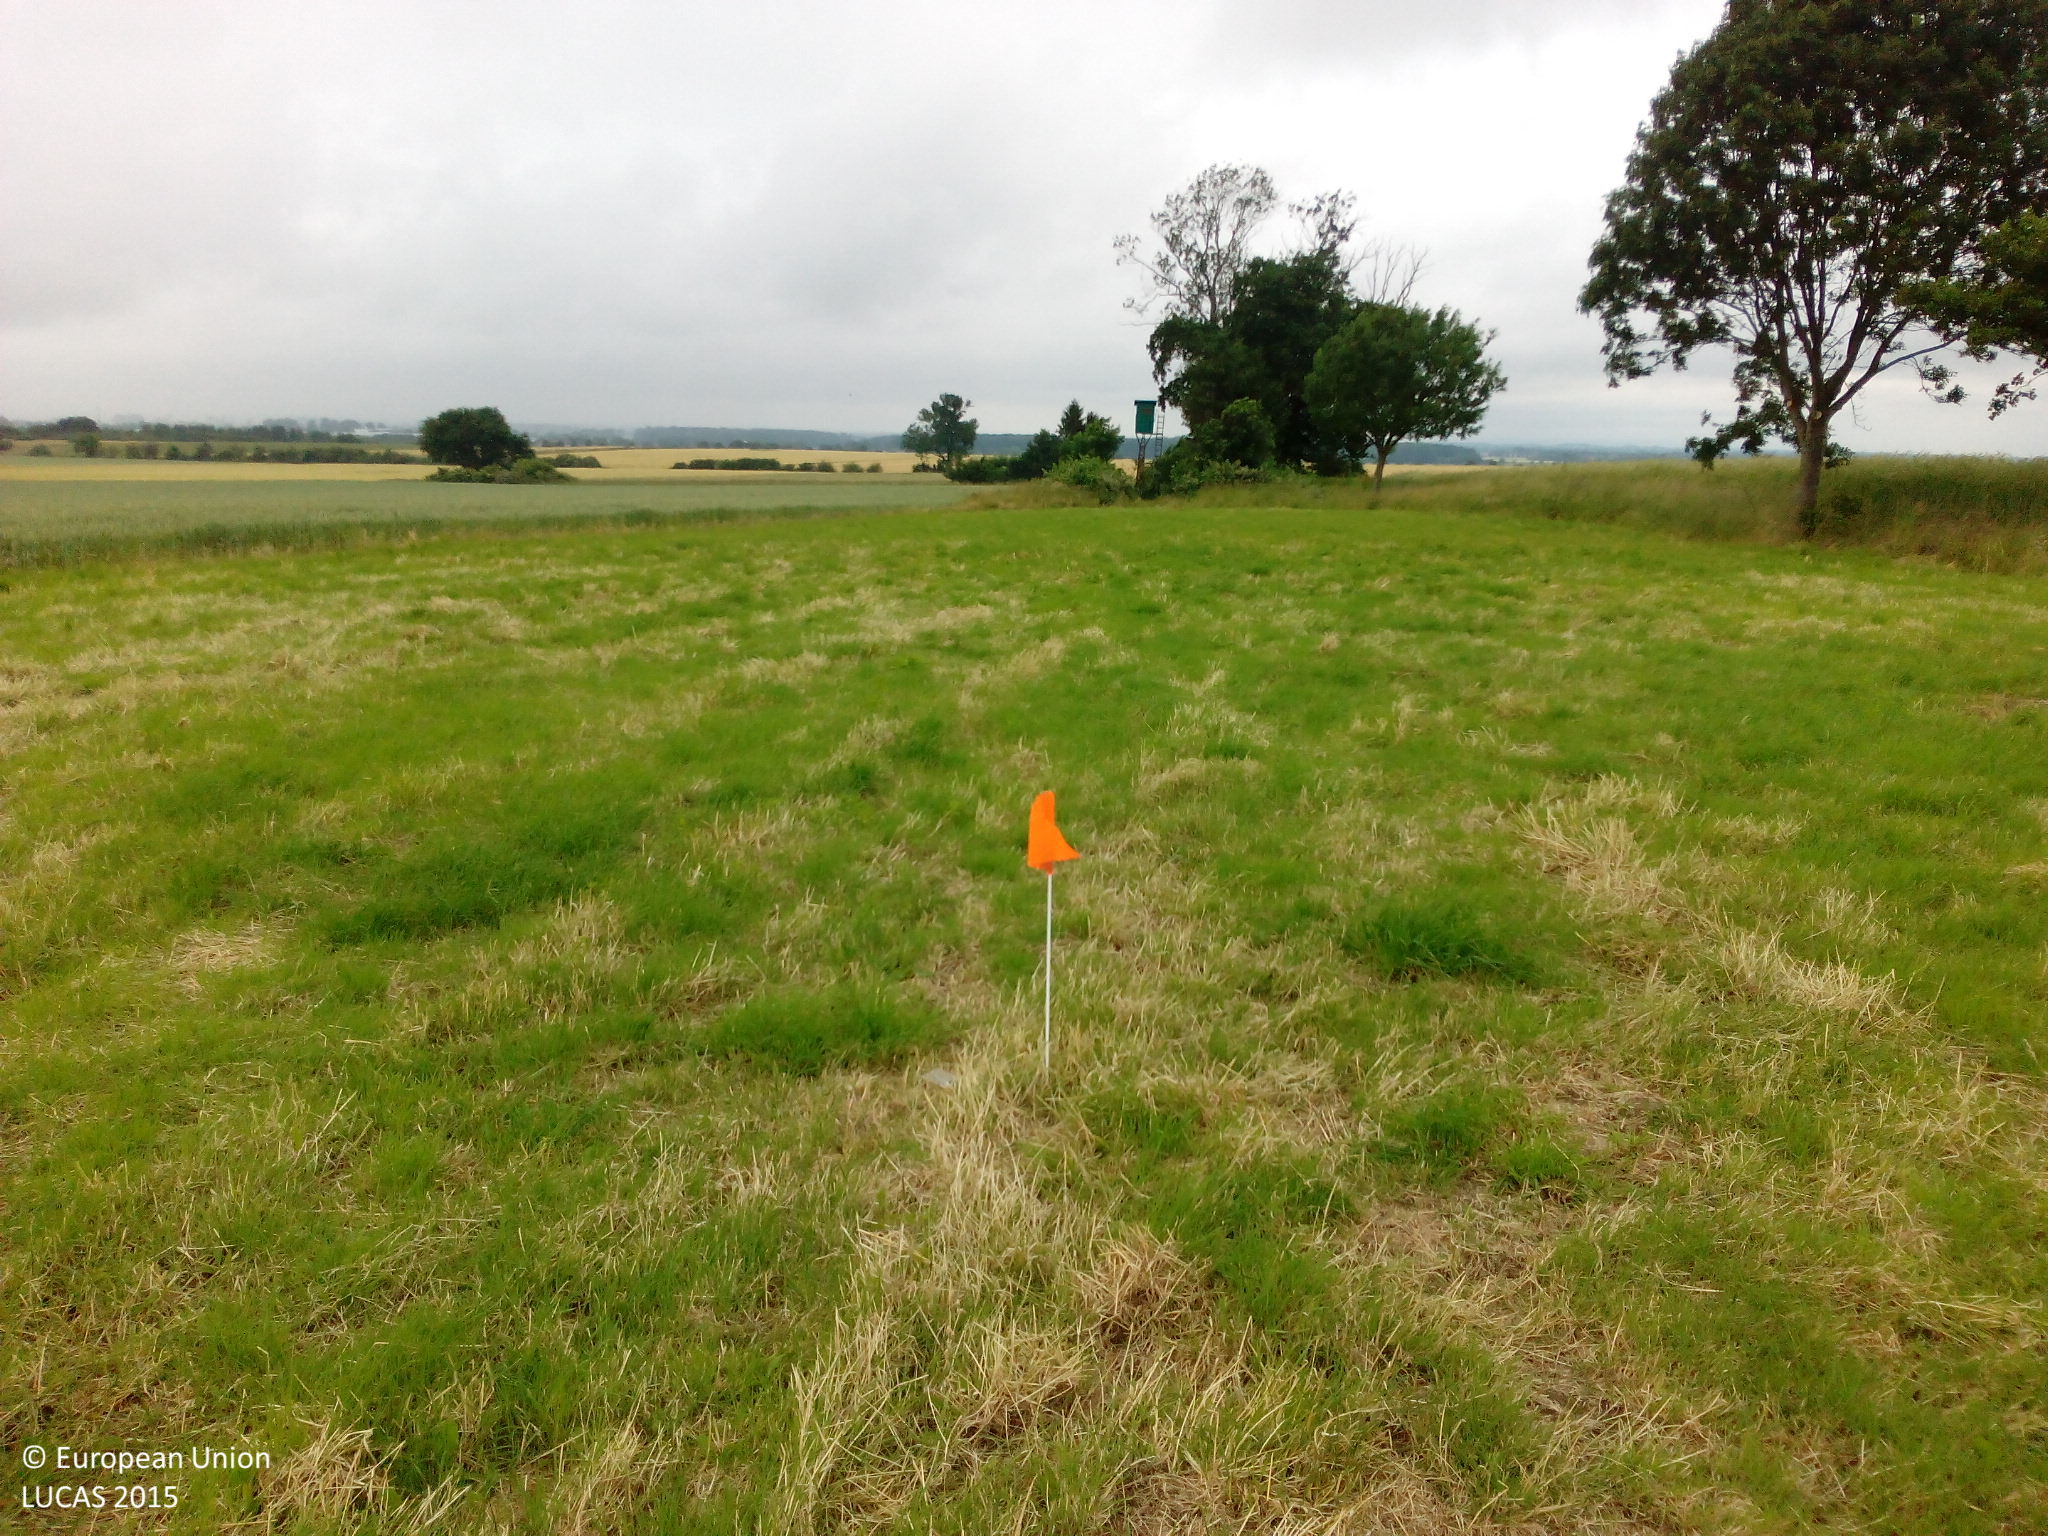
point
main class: Grassland
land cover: Grassland without tree/shrub cover
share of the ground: > 75 %
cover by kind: herbaceous plants 100 %
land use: Agriculture (excluding fallow land and kitchen gardens)
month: June
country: DE
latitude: 51.6318
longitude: 8.5701
